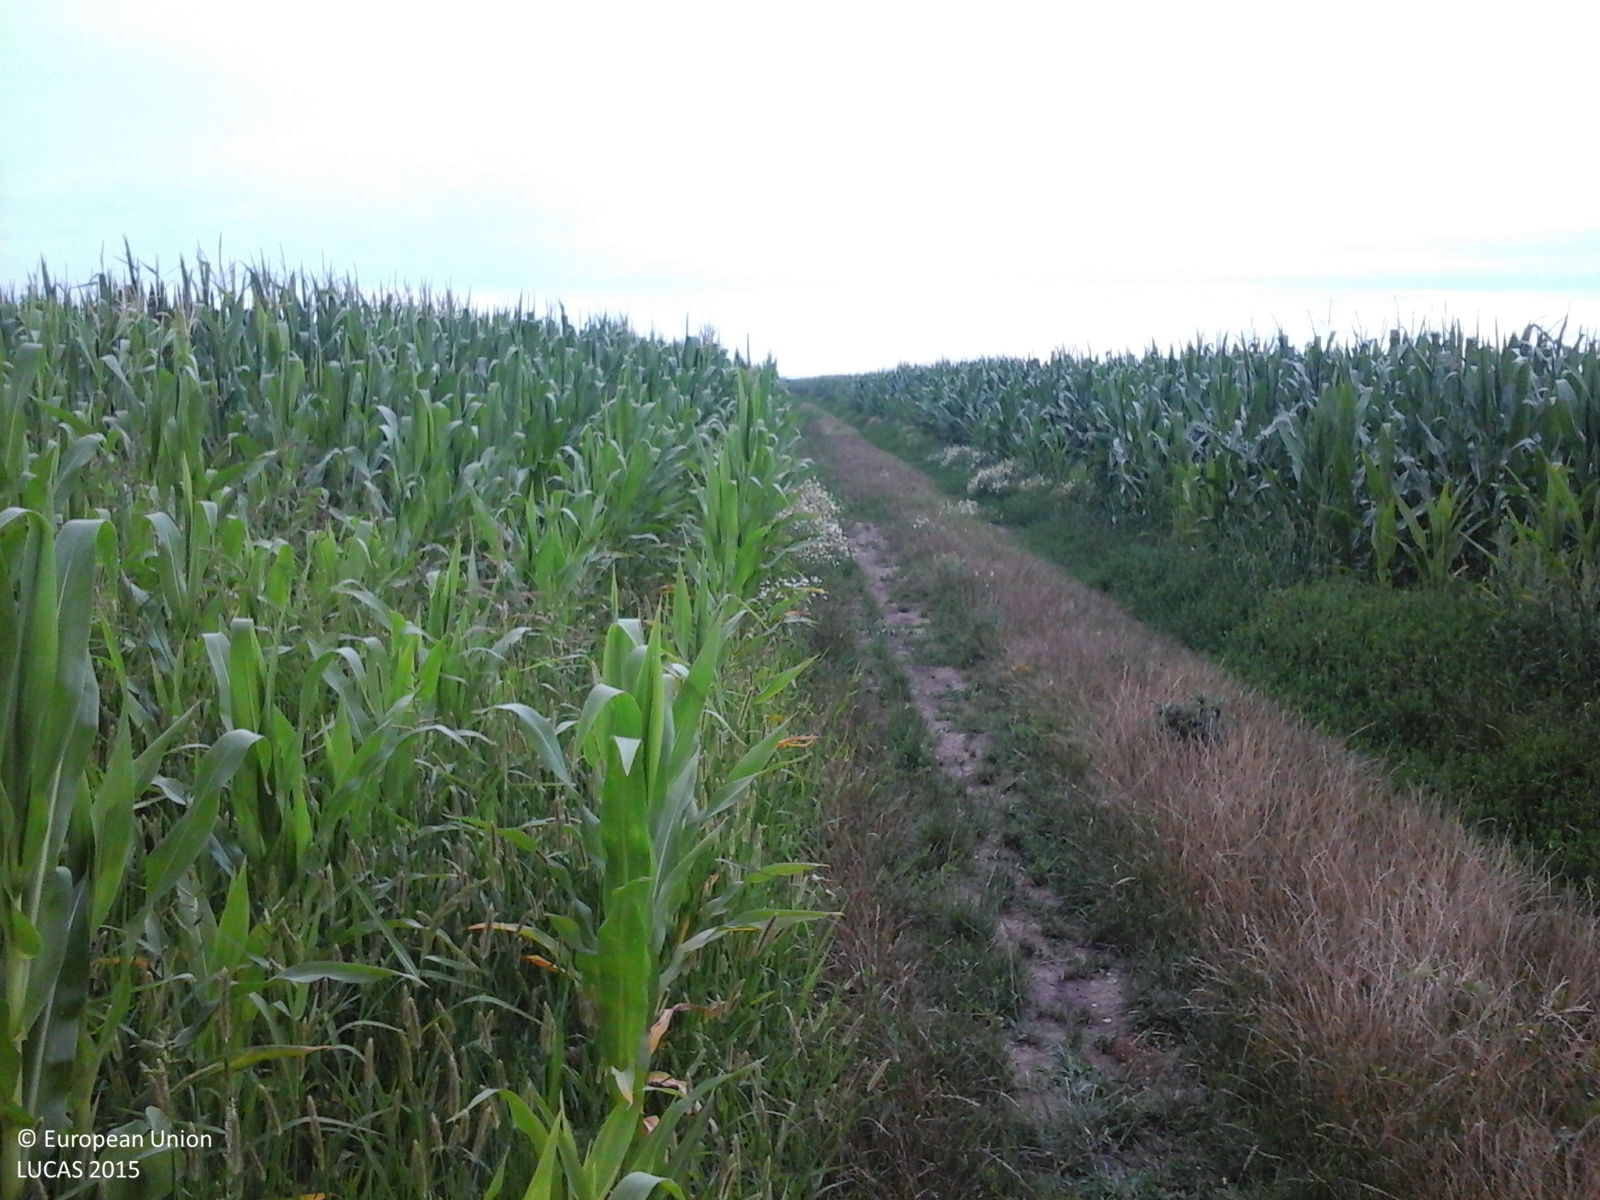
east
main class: Cropland
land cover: Maize
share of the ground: > 75 %
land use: Agriculture (excluding fallow land and kitchen gardens)
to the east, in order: Maize
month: July
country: RO
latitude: 44.1268
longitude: 24.4004
